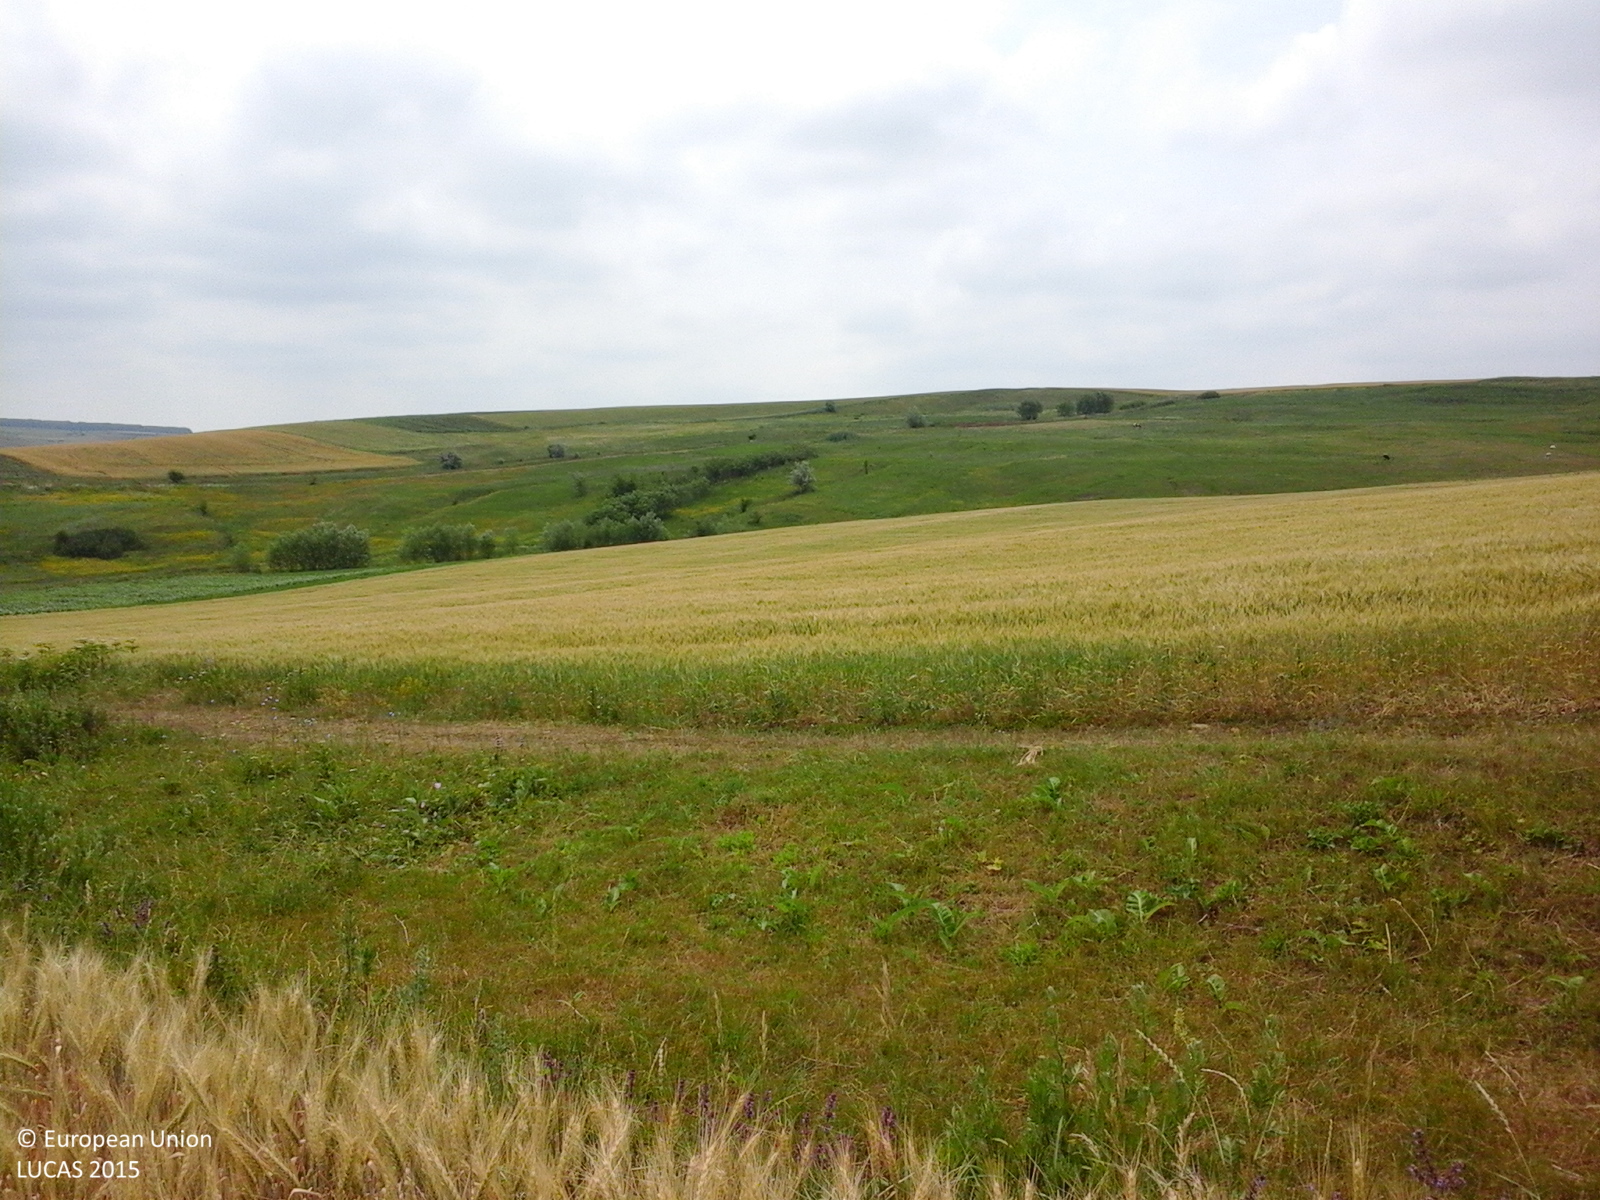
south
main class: Cropland
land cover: Common wheat
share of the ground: > 75 %
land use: Agriculture (excluding fallow land and kitchen gardens)
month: June
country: RO
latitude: 47.9837
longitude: 26.5878
